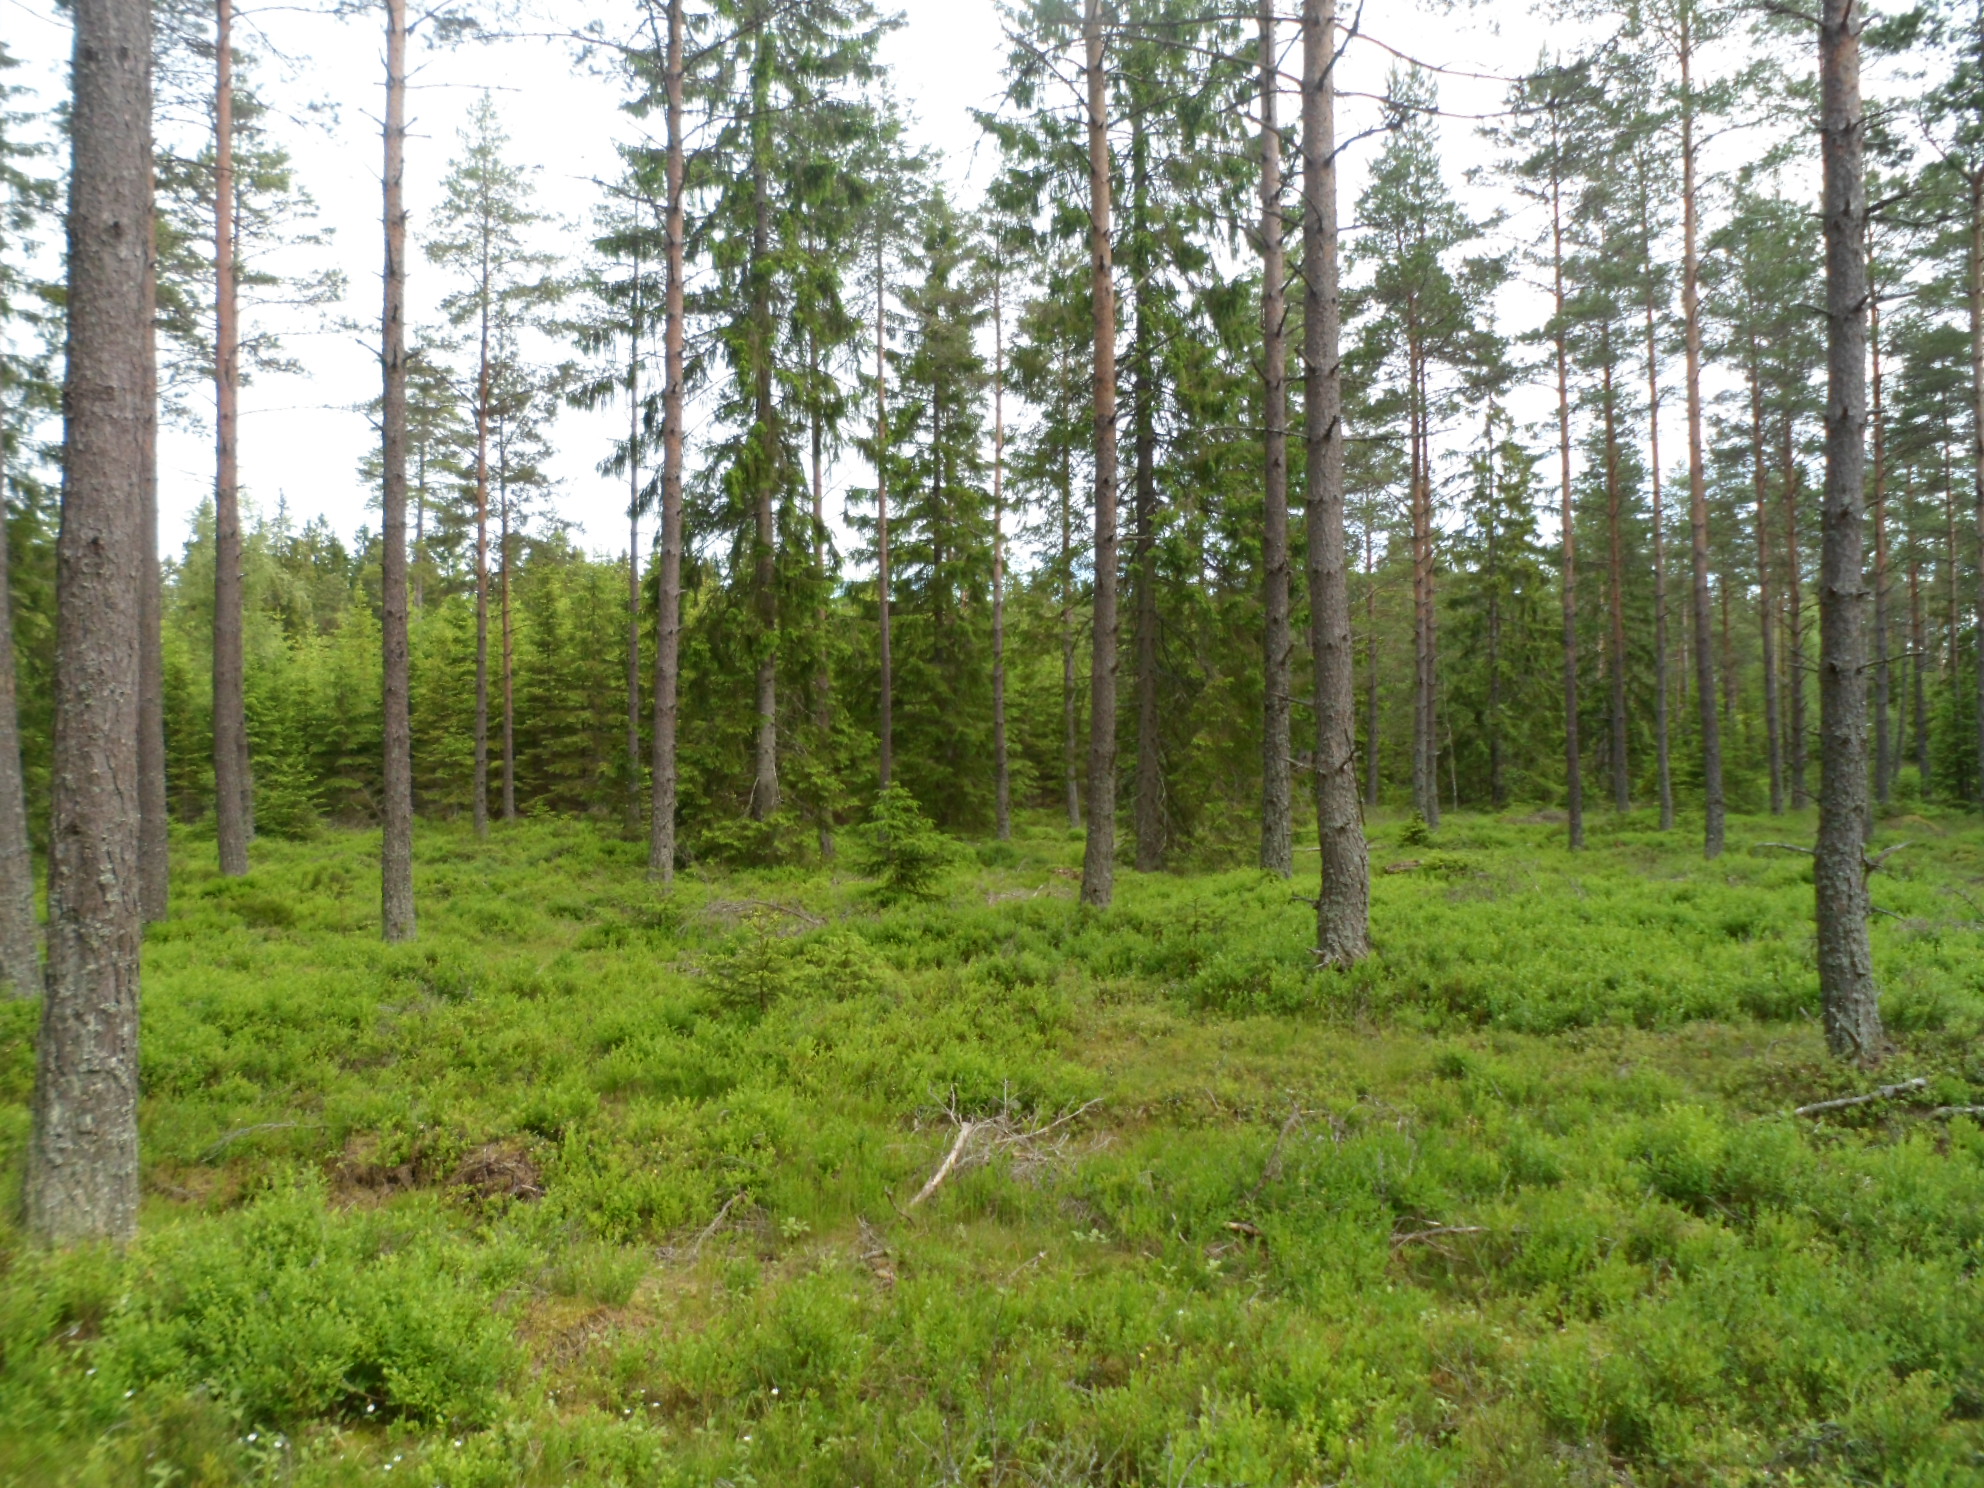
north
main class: Woodland
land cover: Pine dominated coniferous woodland
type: boreal forest
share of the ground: 50 - 75 %
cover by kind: coniferous forest trees 50 %, shrubs 30 %, lichens and mosses 15 %, herbaceous plants 5 %
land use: Forestry
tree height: > 5 m
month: June
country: SE
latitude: 57.0353
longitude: 15.2540
